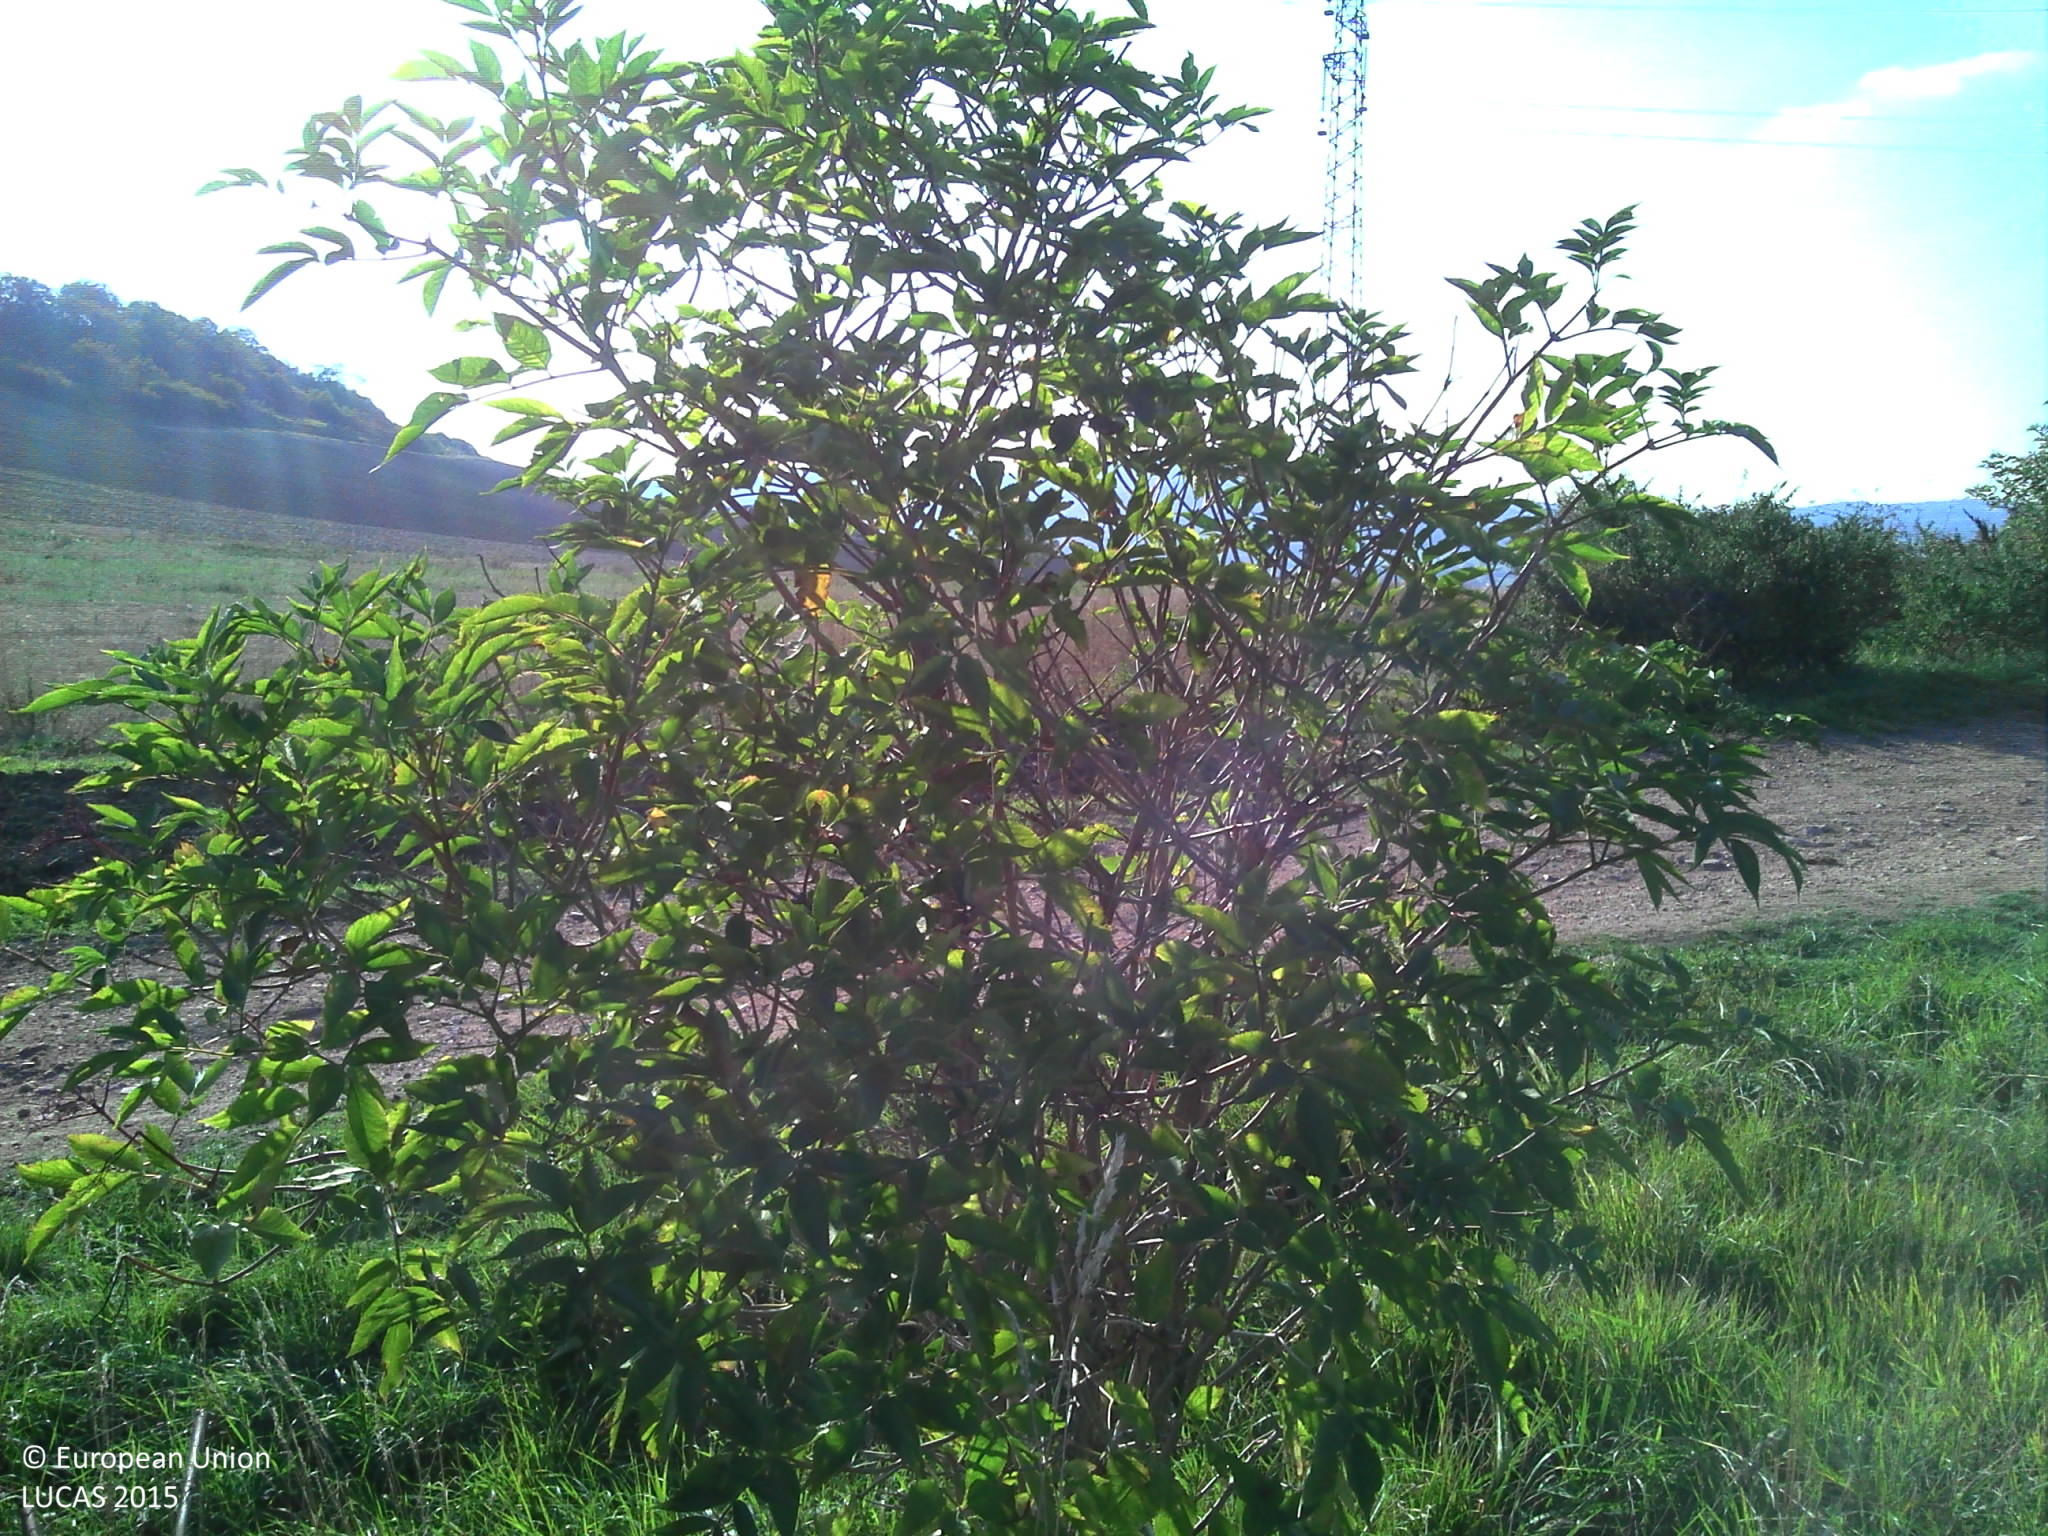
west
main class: Grassland
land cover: Spontaneously vegetated surfaces
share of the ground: 50 - 75 %
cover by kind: herbaceous plants 65 %, unconsolidated bare surface 35 %
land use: Semi-natural and natural areas not in use
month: October
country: FR
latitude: 45.9849
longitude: 3.1187
